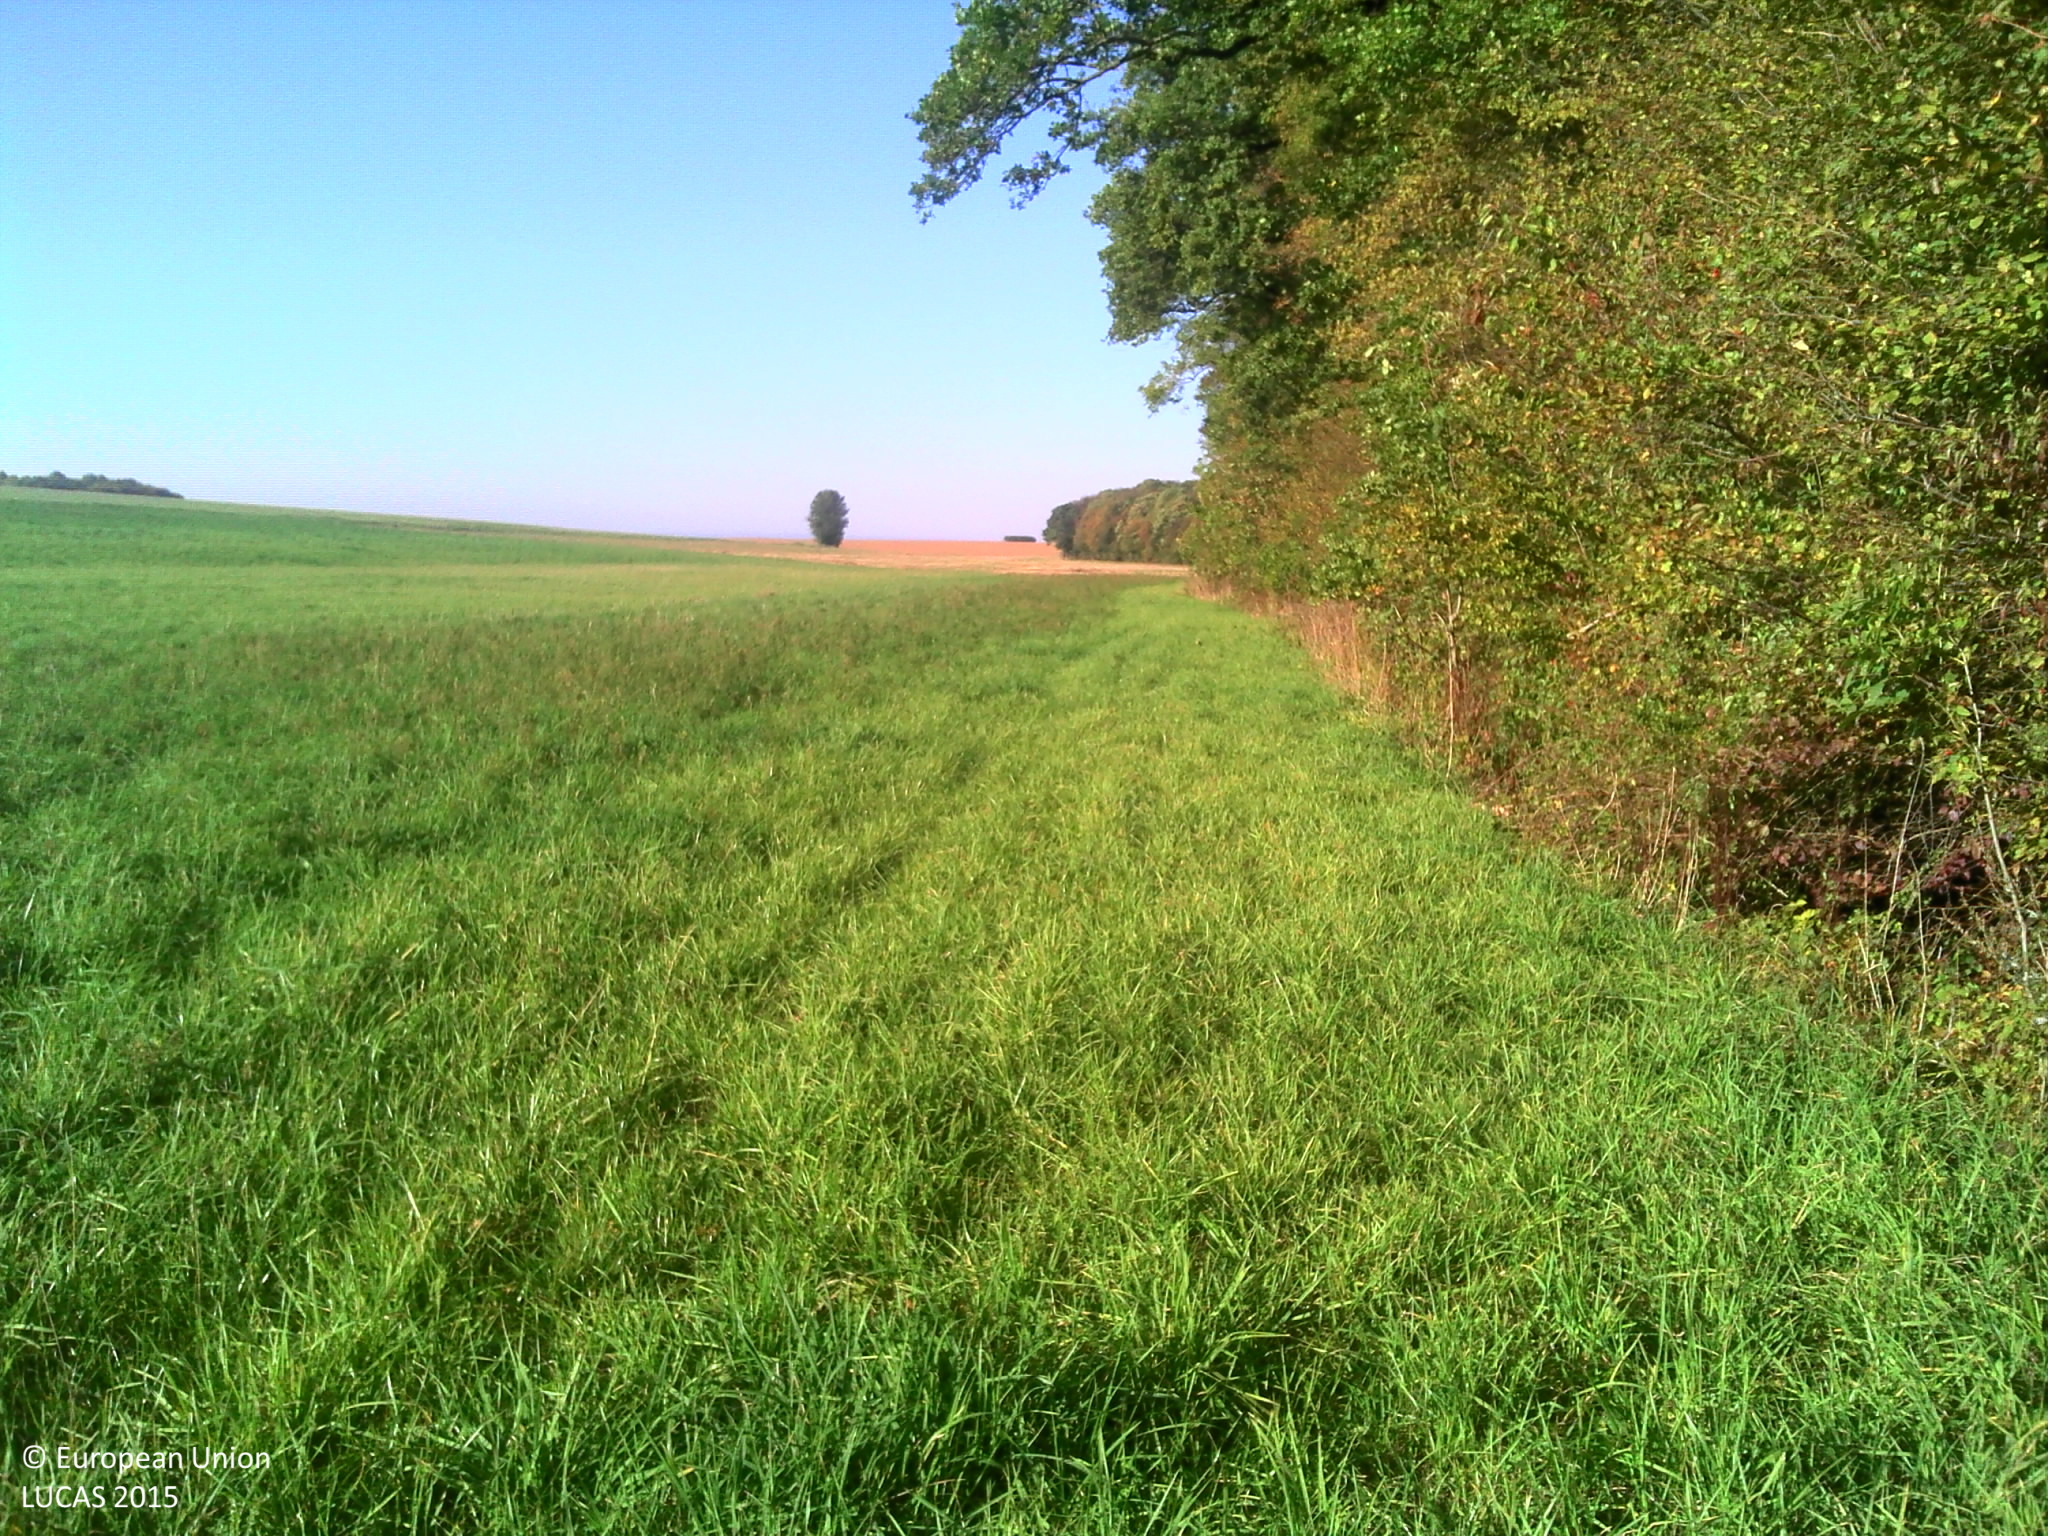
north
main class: Cropland
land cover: Temporary grasslands
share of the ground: > 75 %
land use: Agriculture (excluding fallow land and kitchen gardens)
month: October
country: FR
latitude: 49.1411
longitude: 5.9831
